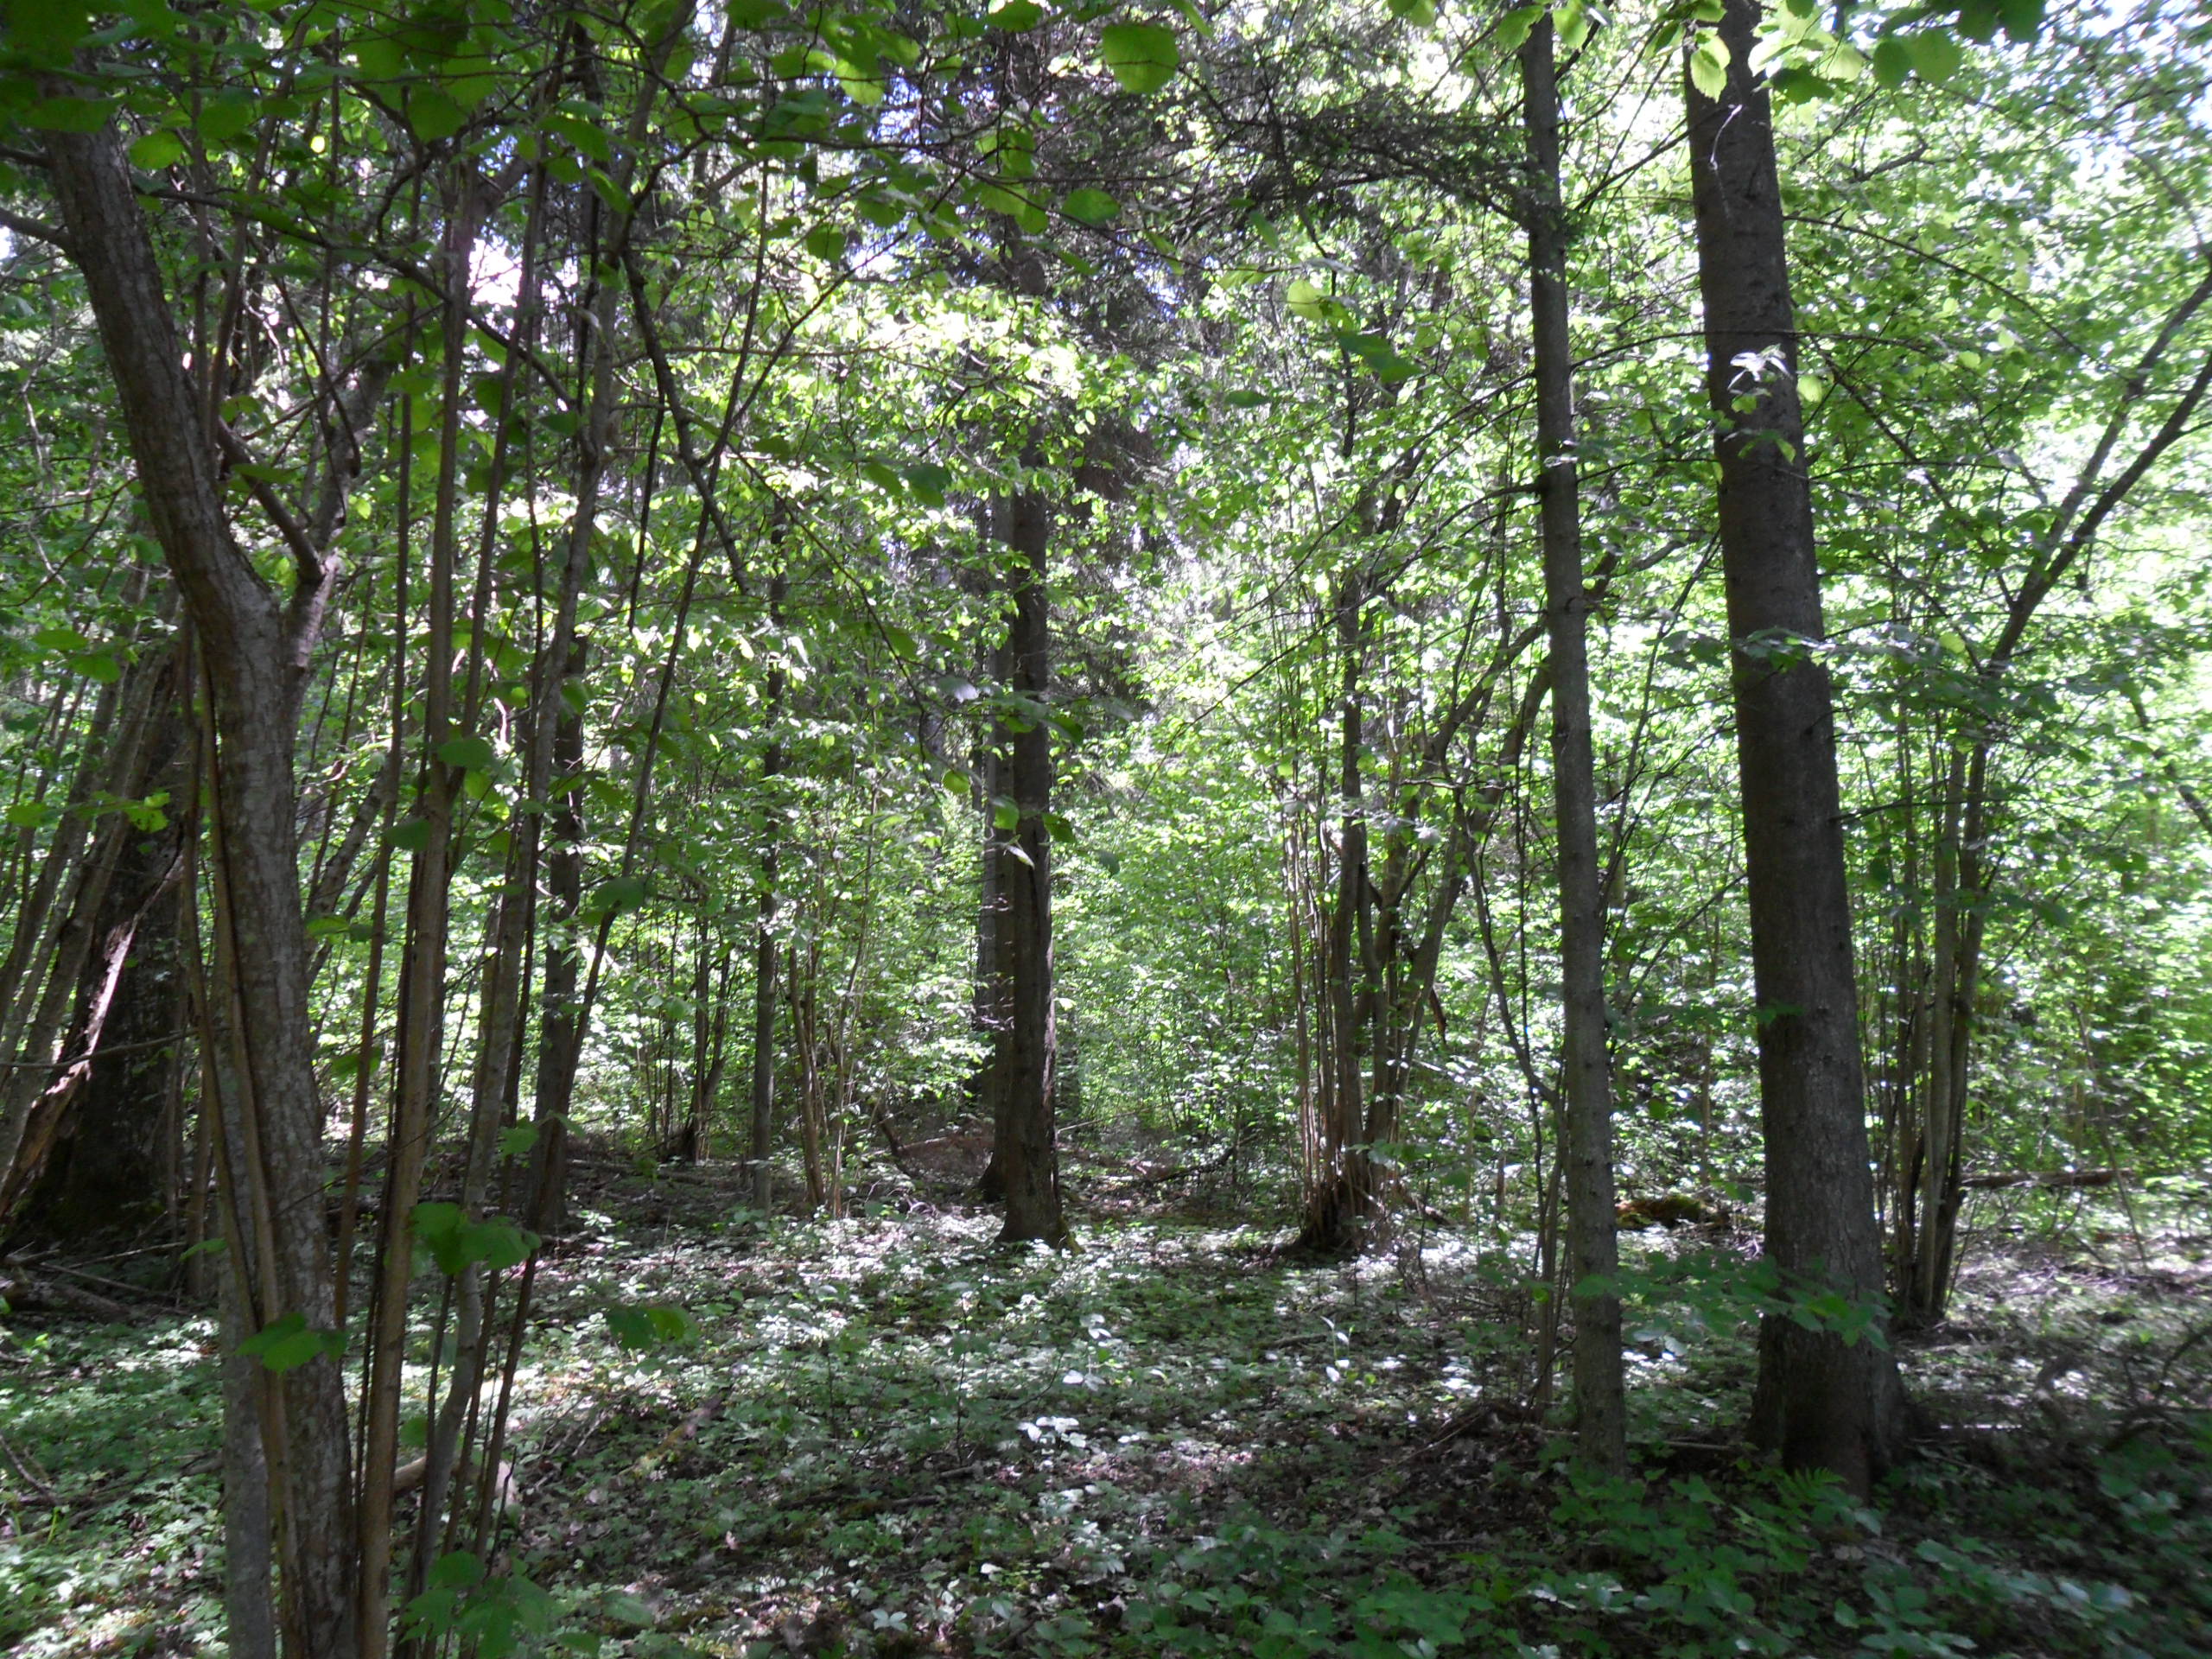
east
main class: Woodland
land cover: Broadleaved woodland
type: non-riverine alder, birch or aspen forest
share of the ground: > 75 %
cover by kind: broadleaved forest trees 70 %, coniferous forest trees 20 %, shrubs 5 %, herbaceous plants 5 %
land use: Forestry
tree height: > 5 m
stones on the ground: < 10 %
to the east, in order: Broadleaved woodland; Pine dominated mixed woodland
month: June
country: LV
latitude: 57.3882
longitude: 22.5818
